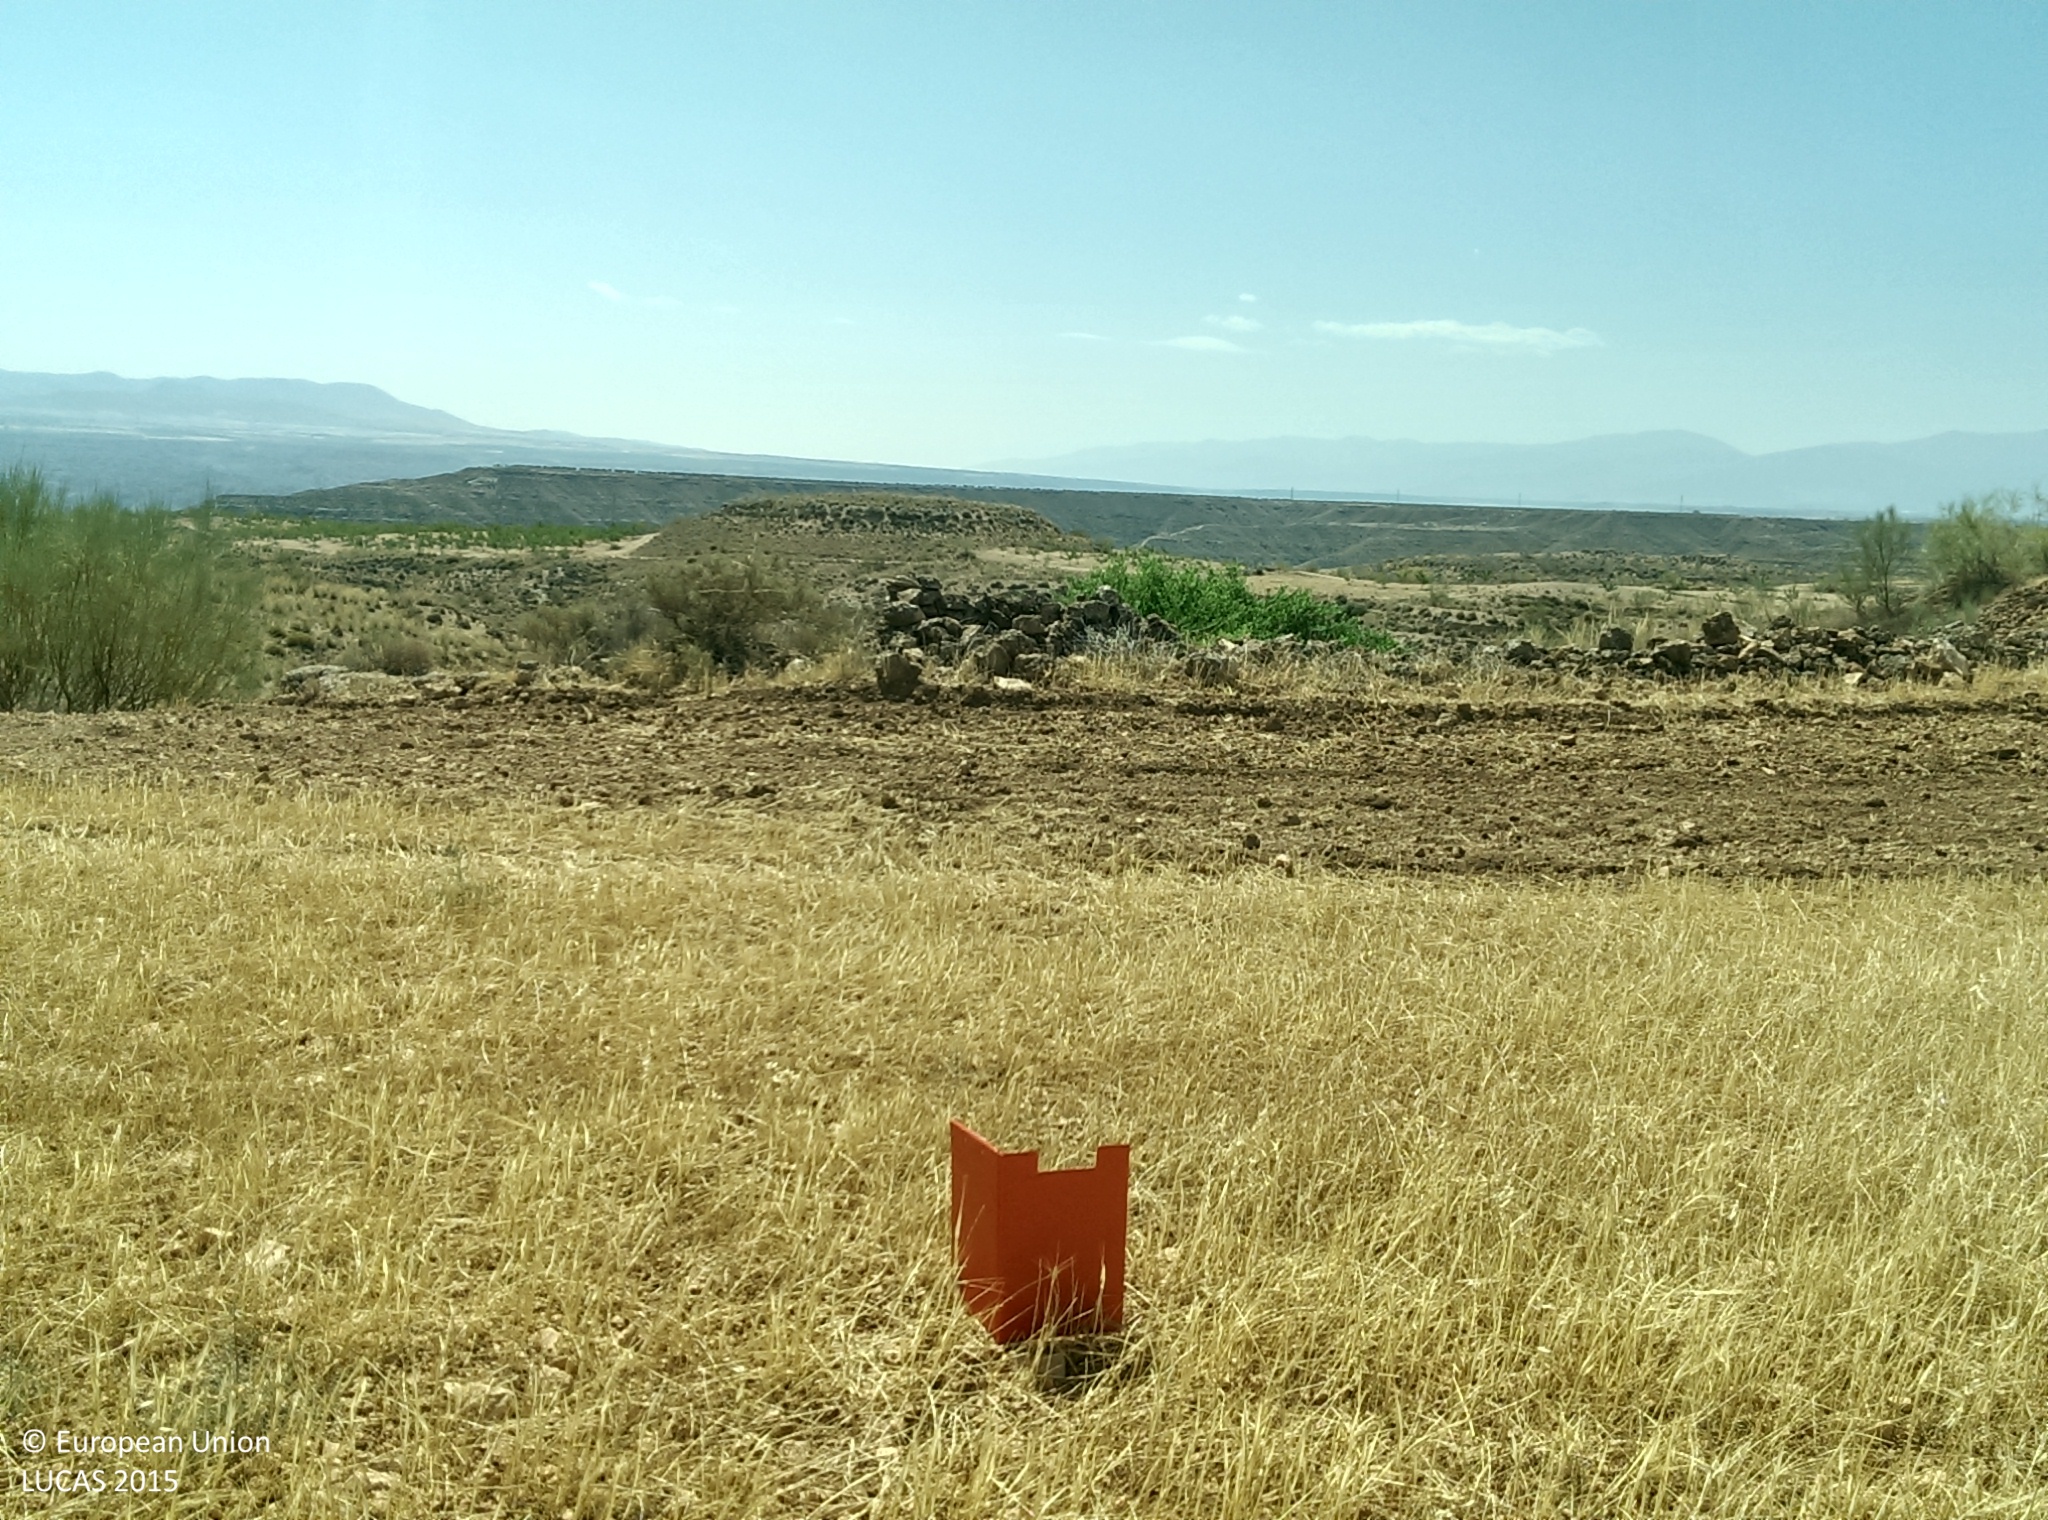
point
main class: Cropland
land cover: Barley
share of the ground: < 10 %
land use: Agriculture (excluding fallow land and kitchen gardens)
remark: Harvested field
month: July
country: ES
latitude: 37.3897
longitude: -3.2155
